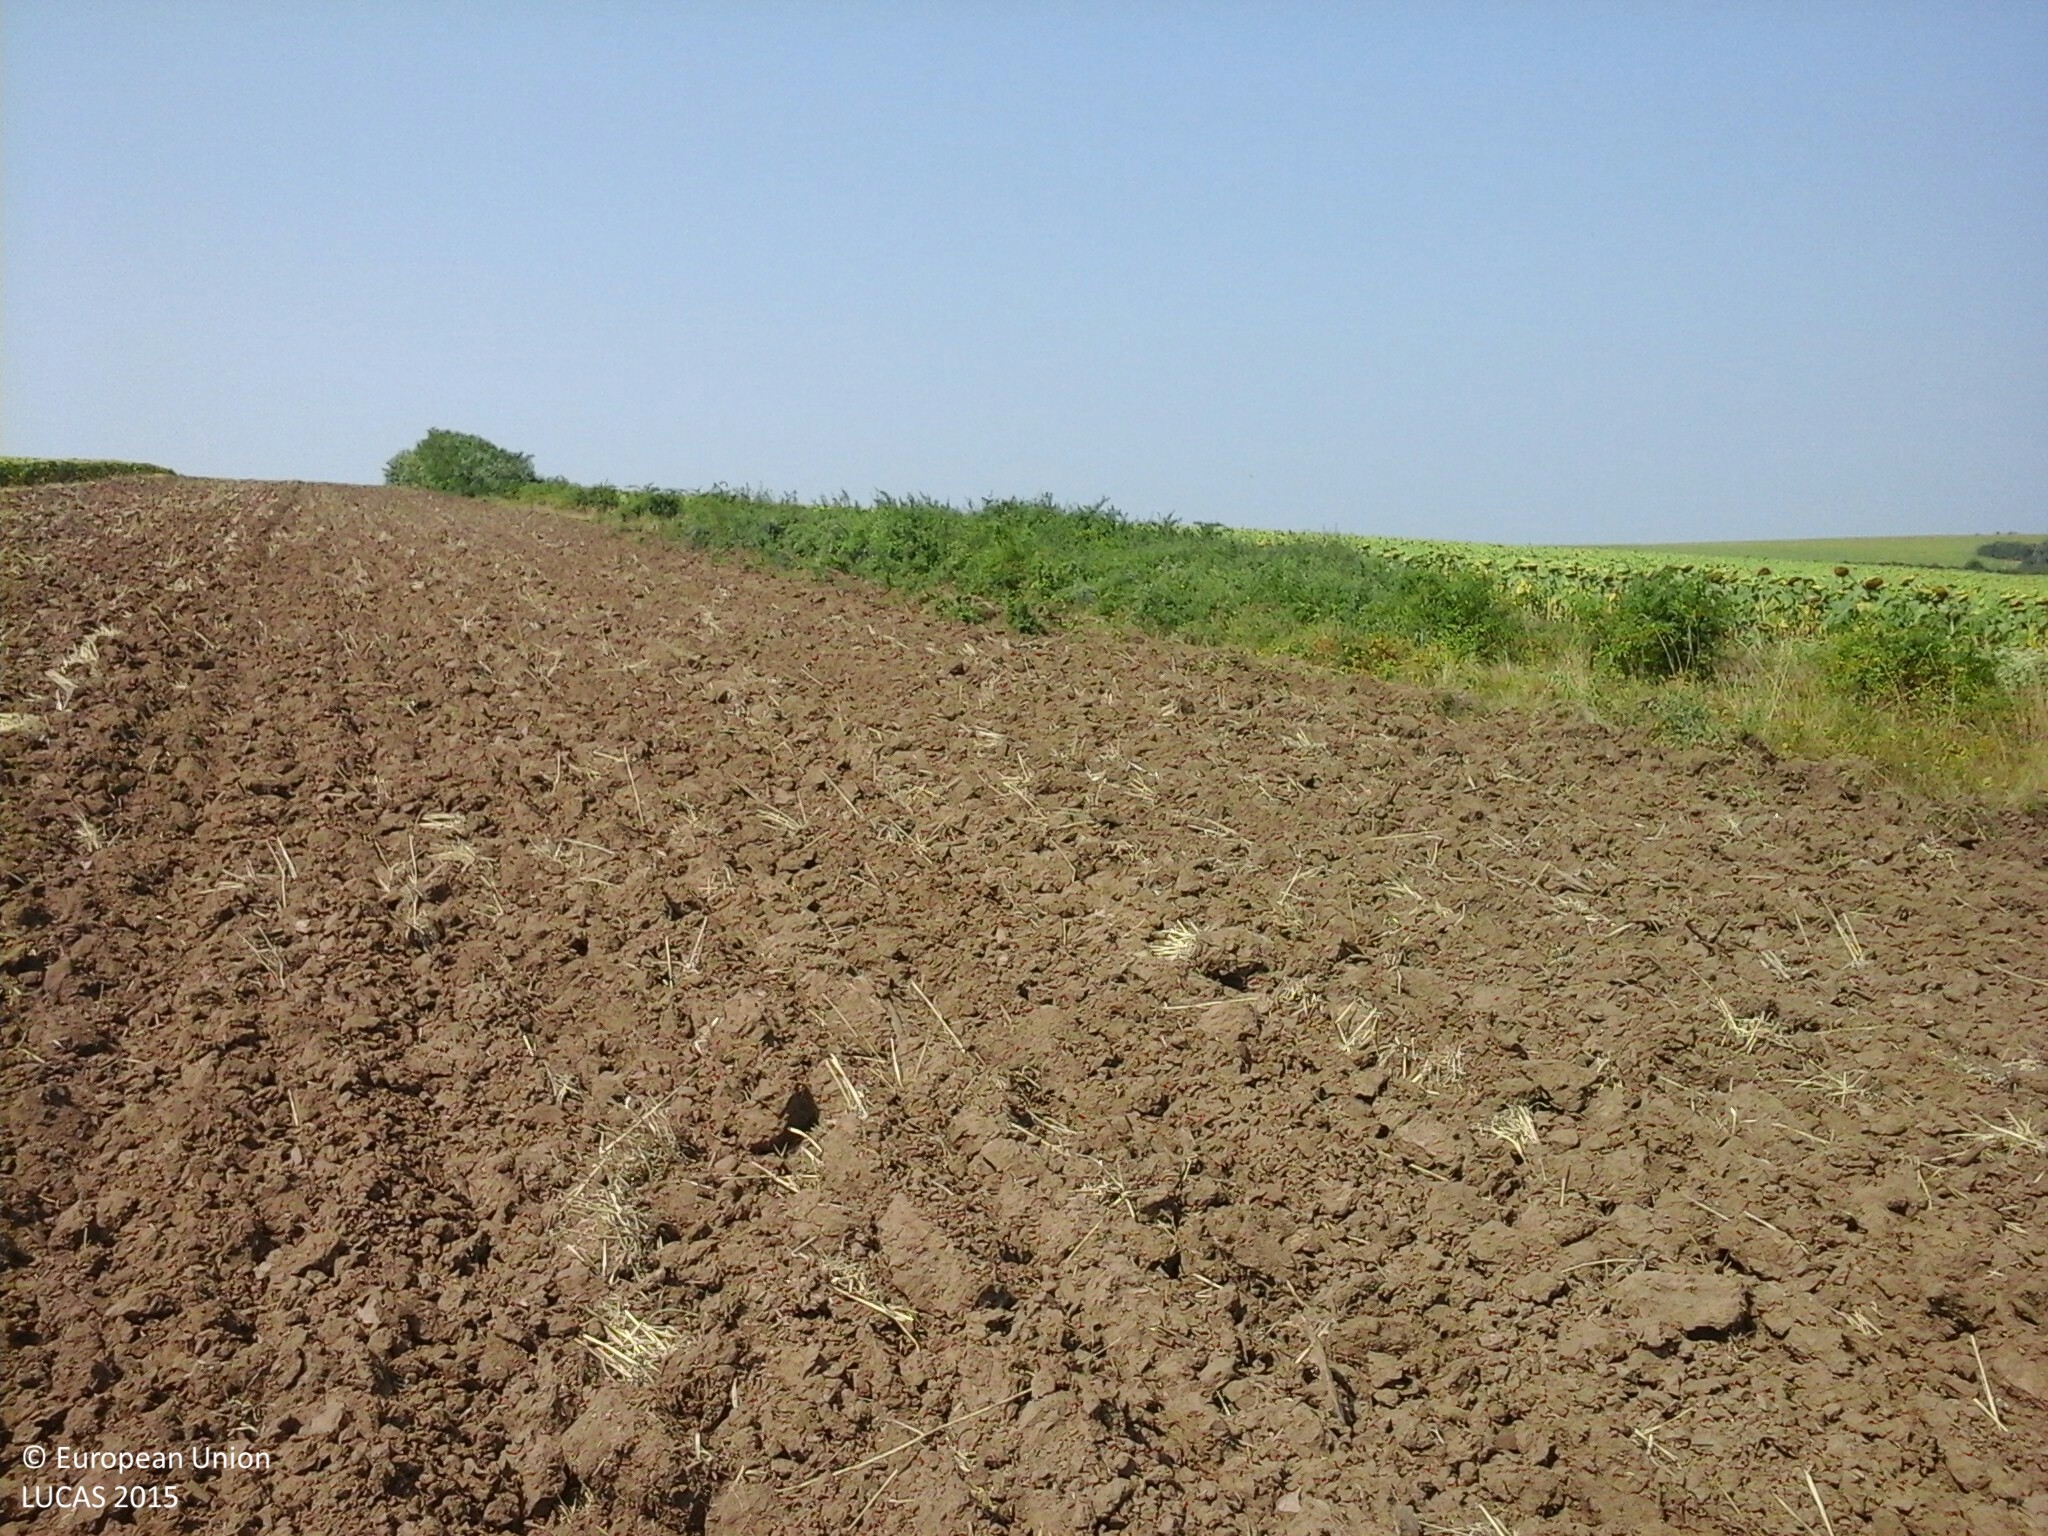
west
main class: Cropland
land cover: Common wheat
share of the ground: < 10 %
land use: Agriculture (excluding fallow land and kitchen gardens)
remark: Harvested field
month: August
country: HU
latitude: 47.9368
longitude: 20.7040
